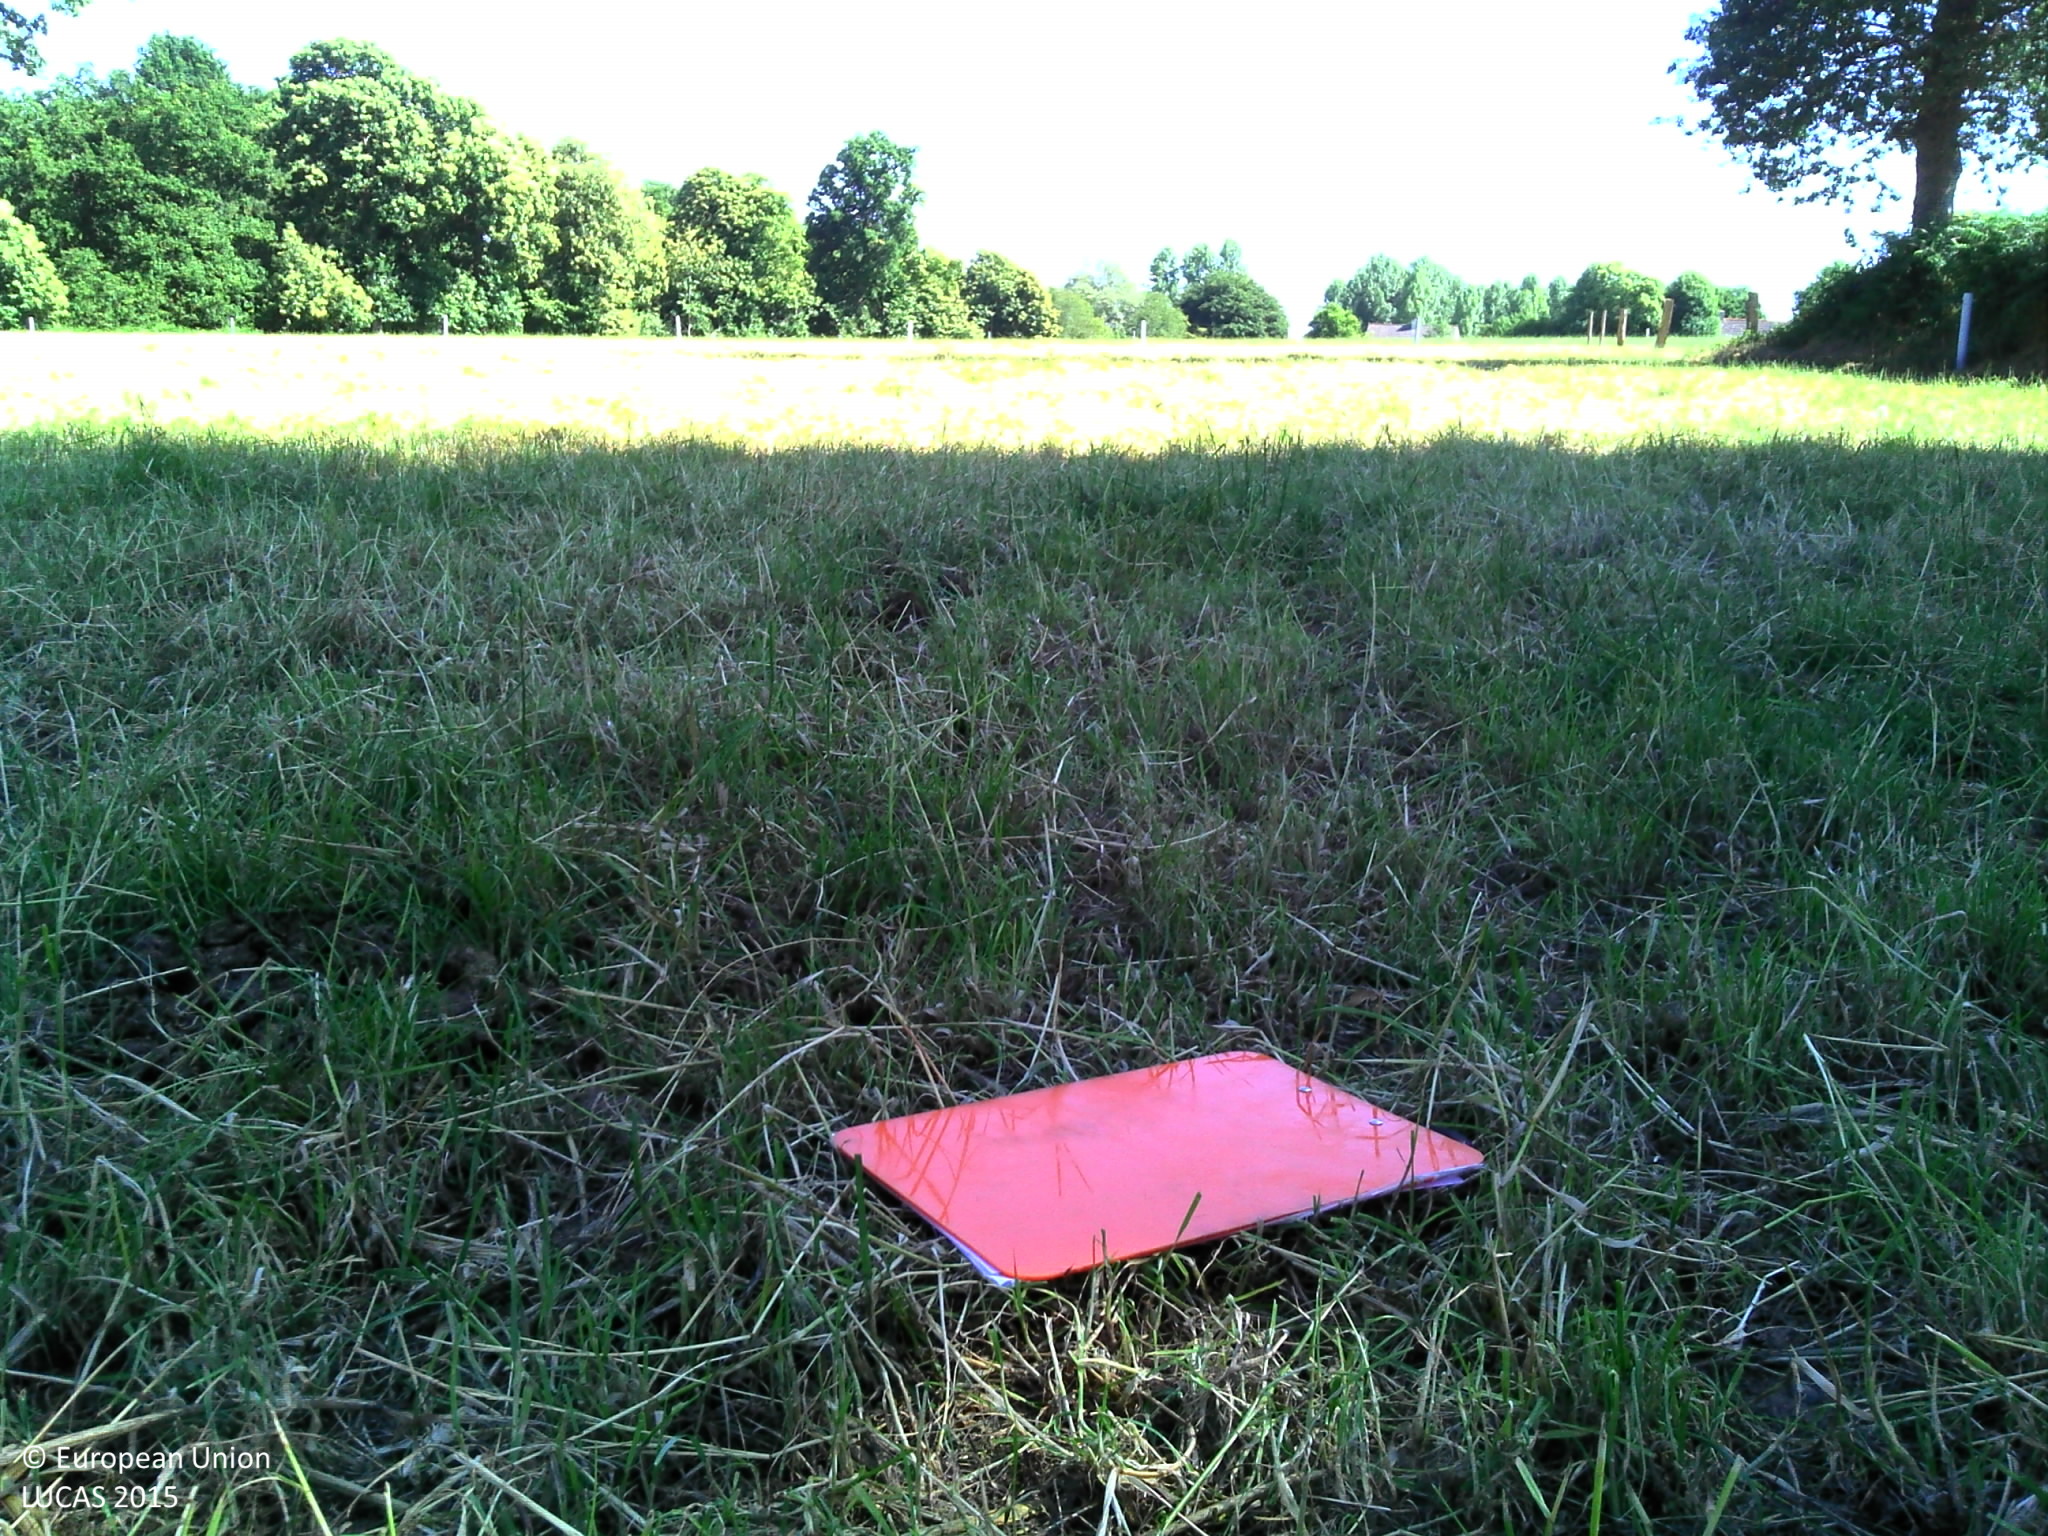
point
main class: Grassland
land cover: Grassland without tree/shrub cover
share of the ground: > 75 %
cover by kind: herbaceous plants 100 %
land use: Agriculture (excluding fallow land and kitchen gardens)
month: July
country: FR
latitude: 48.3865
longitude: -2.1414
